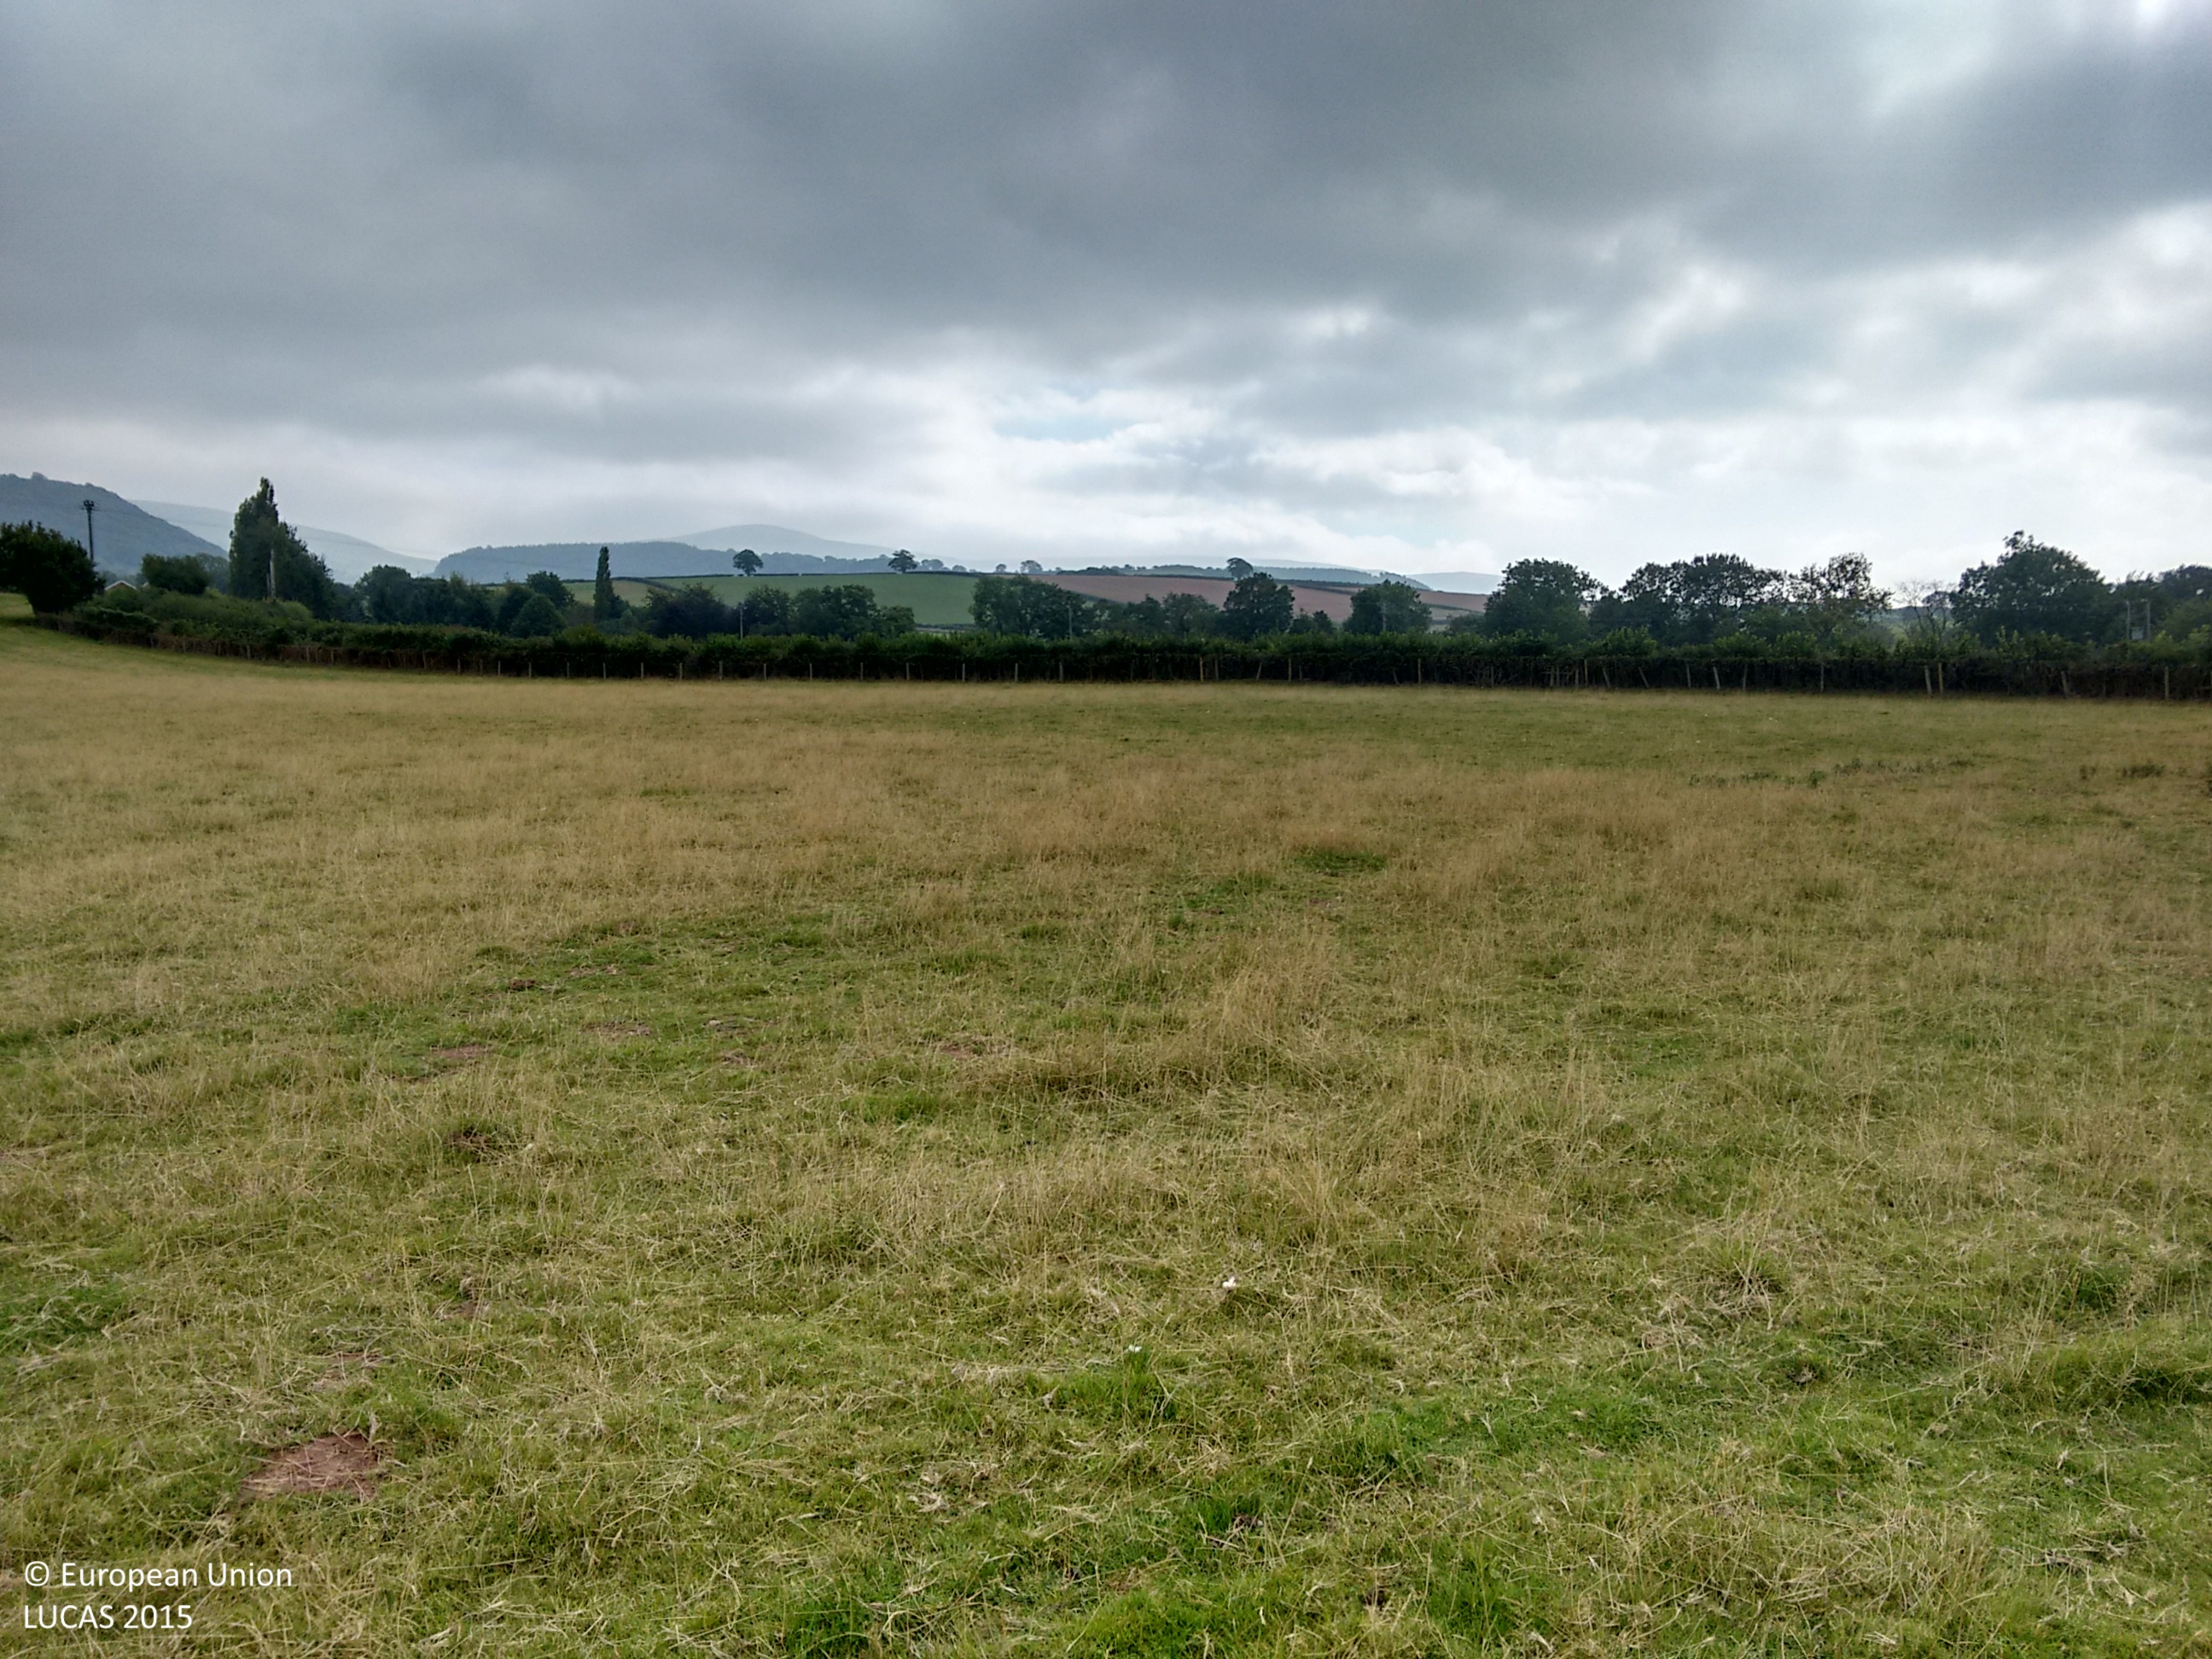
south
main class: Grassland
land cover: Grassland without tree/shrub cover
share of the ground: > 75 %
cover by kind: herbaceous plants 100 %
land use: Agriculture (excluding fallow land and kitchen gardens)
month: September
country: GB
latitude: 52.0598
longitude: -3.1611
